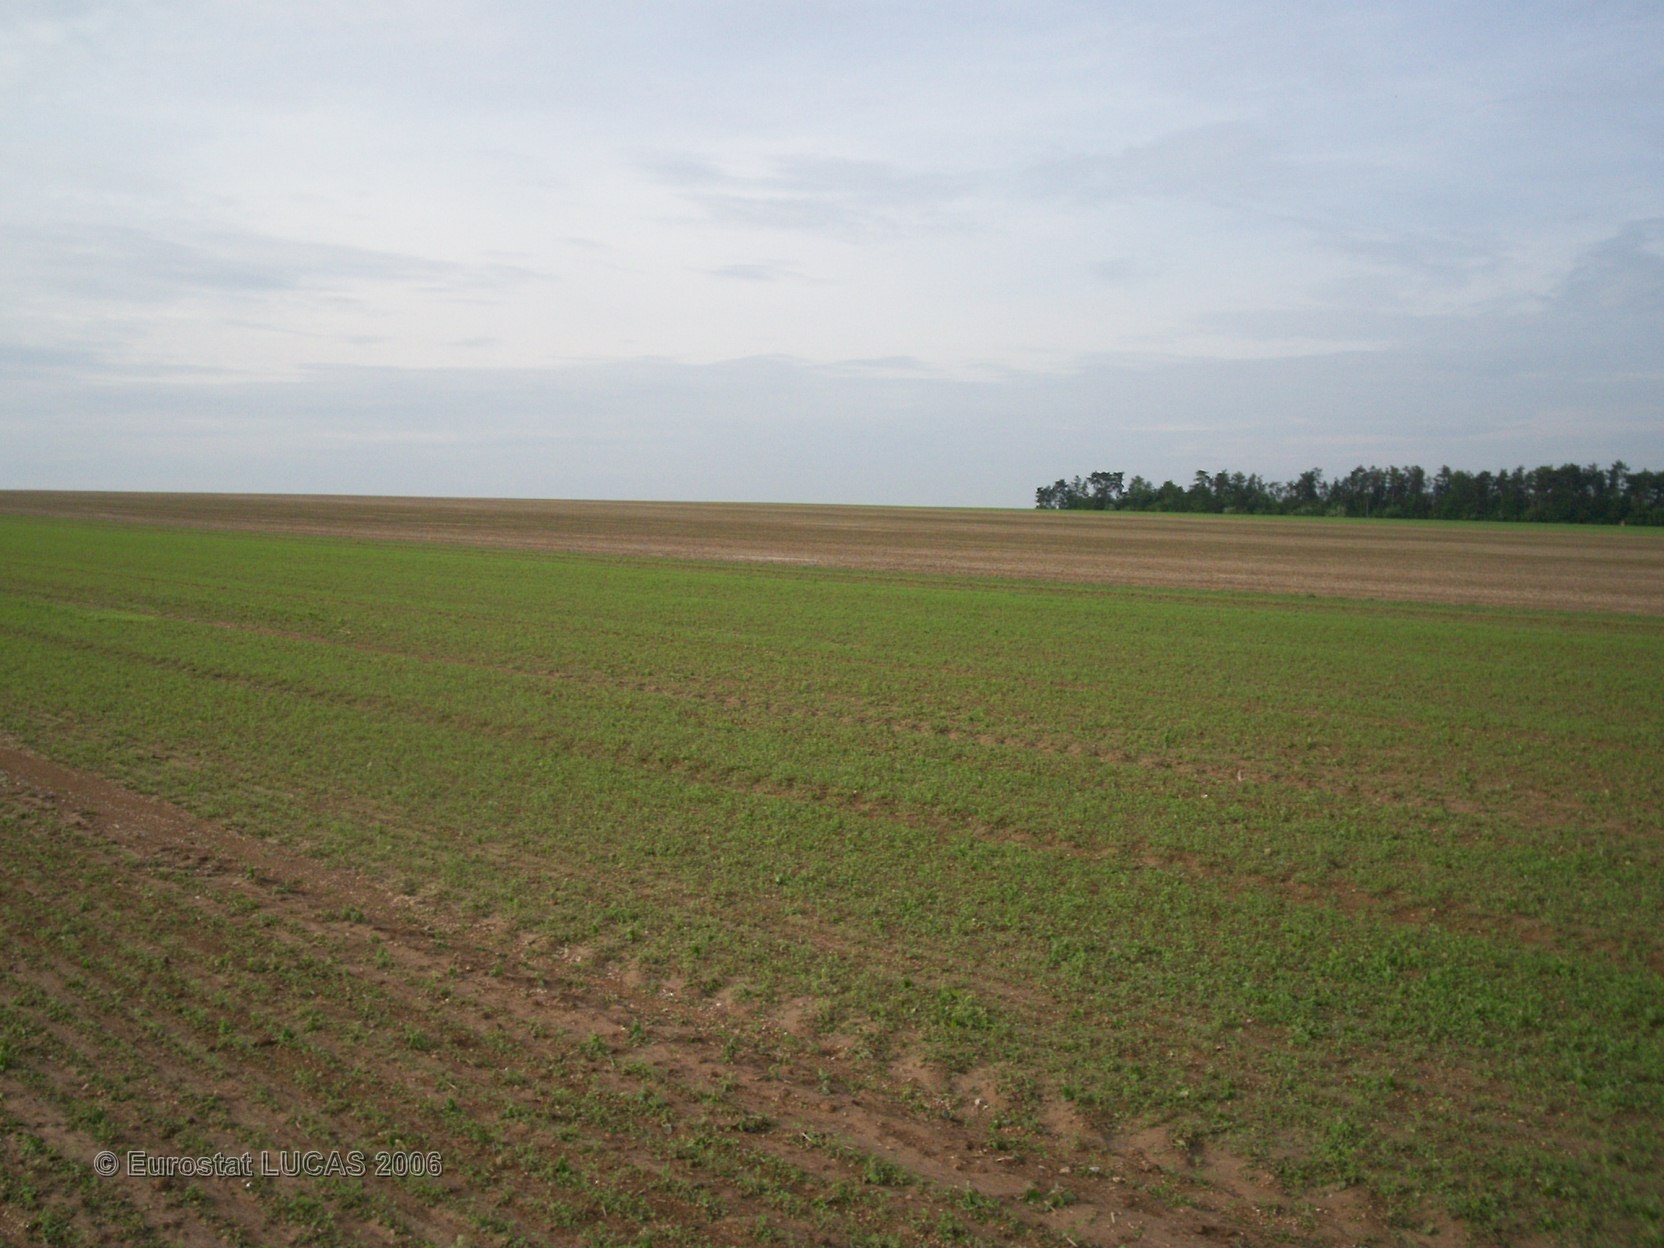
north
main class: Cropland
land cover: Lucerne
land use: Agriculture (excluding fallow land and kitchen gardens)
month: May
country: FR
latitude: 49.1792
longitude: 4.3579
